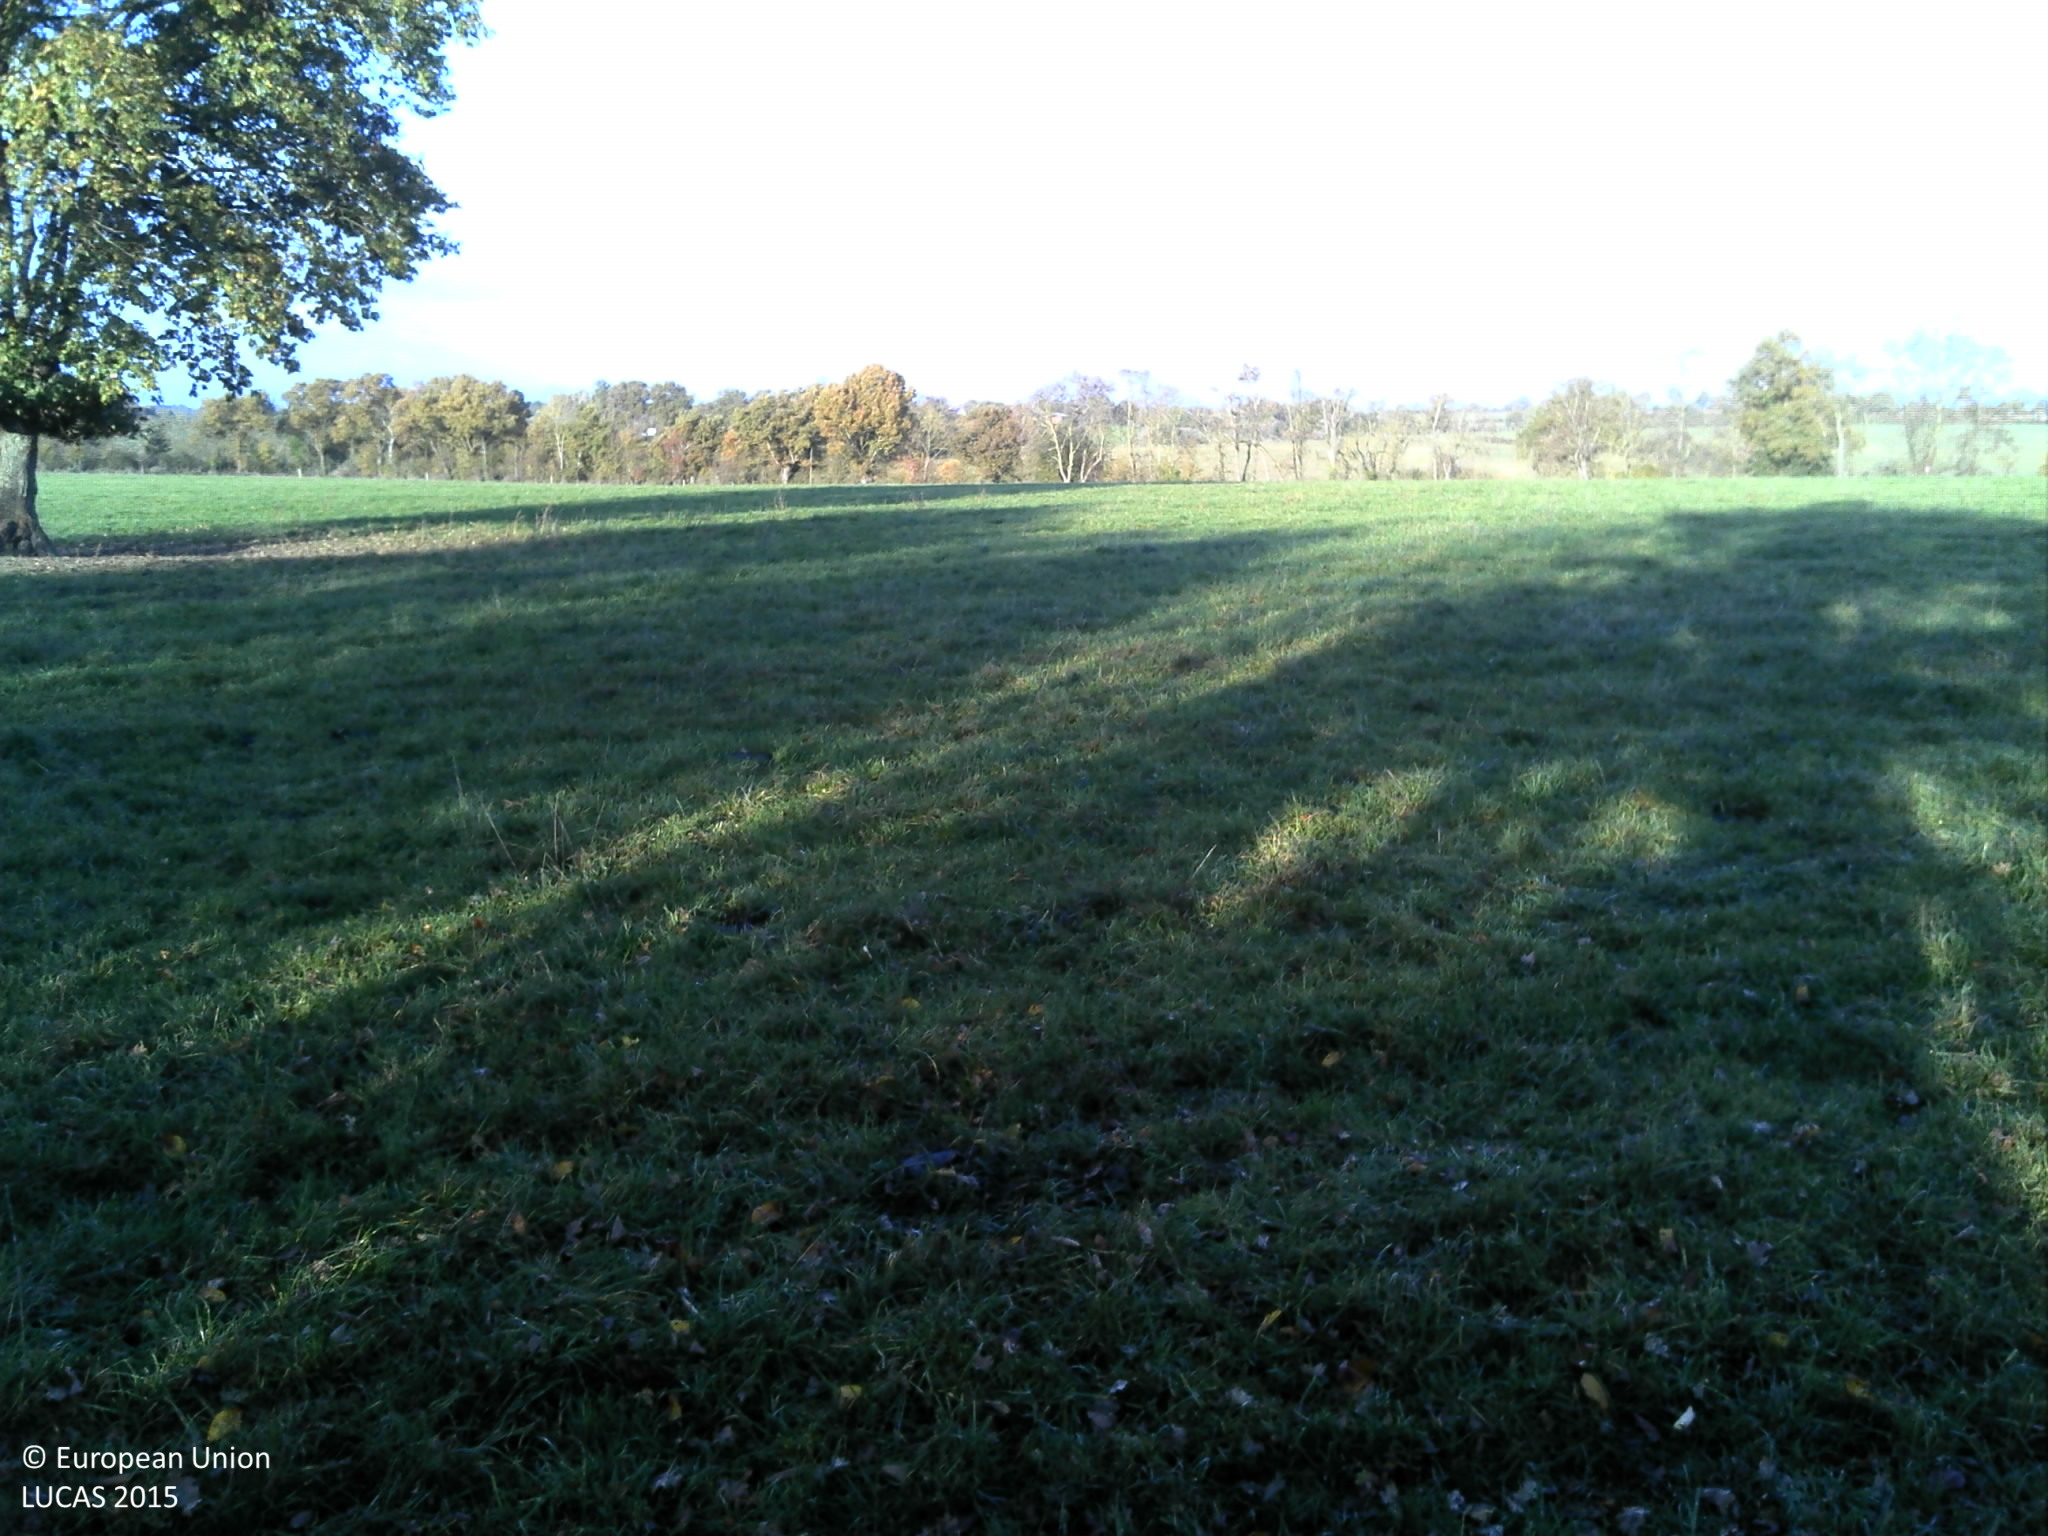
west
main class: Grassland
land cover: Grassland with sparse tree/shrub cover
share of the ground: > 75 %
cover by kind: herbaceous plants 95 %, broadleaved forest trees 5 %
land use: Agriculture (excluding fallow land and kitchen gardens)
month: November
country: FR
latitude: 47.5923
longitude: -1.0622
